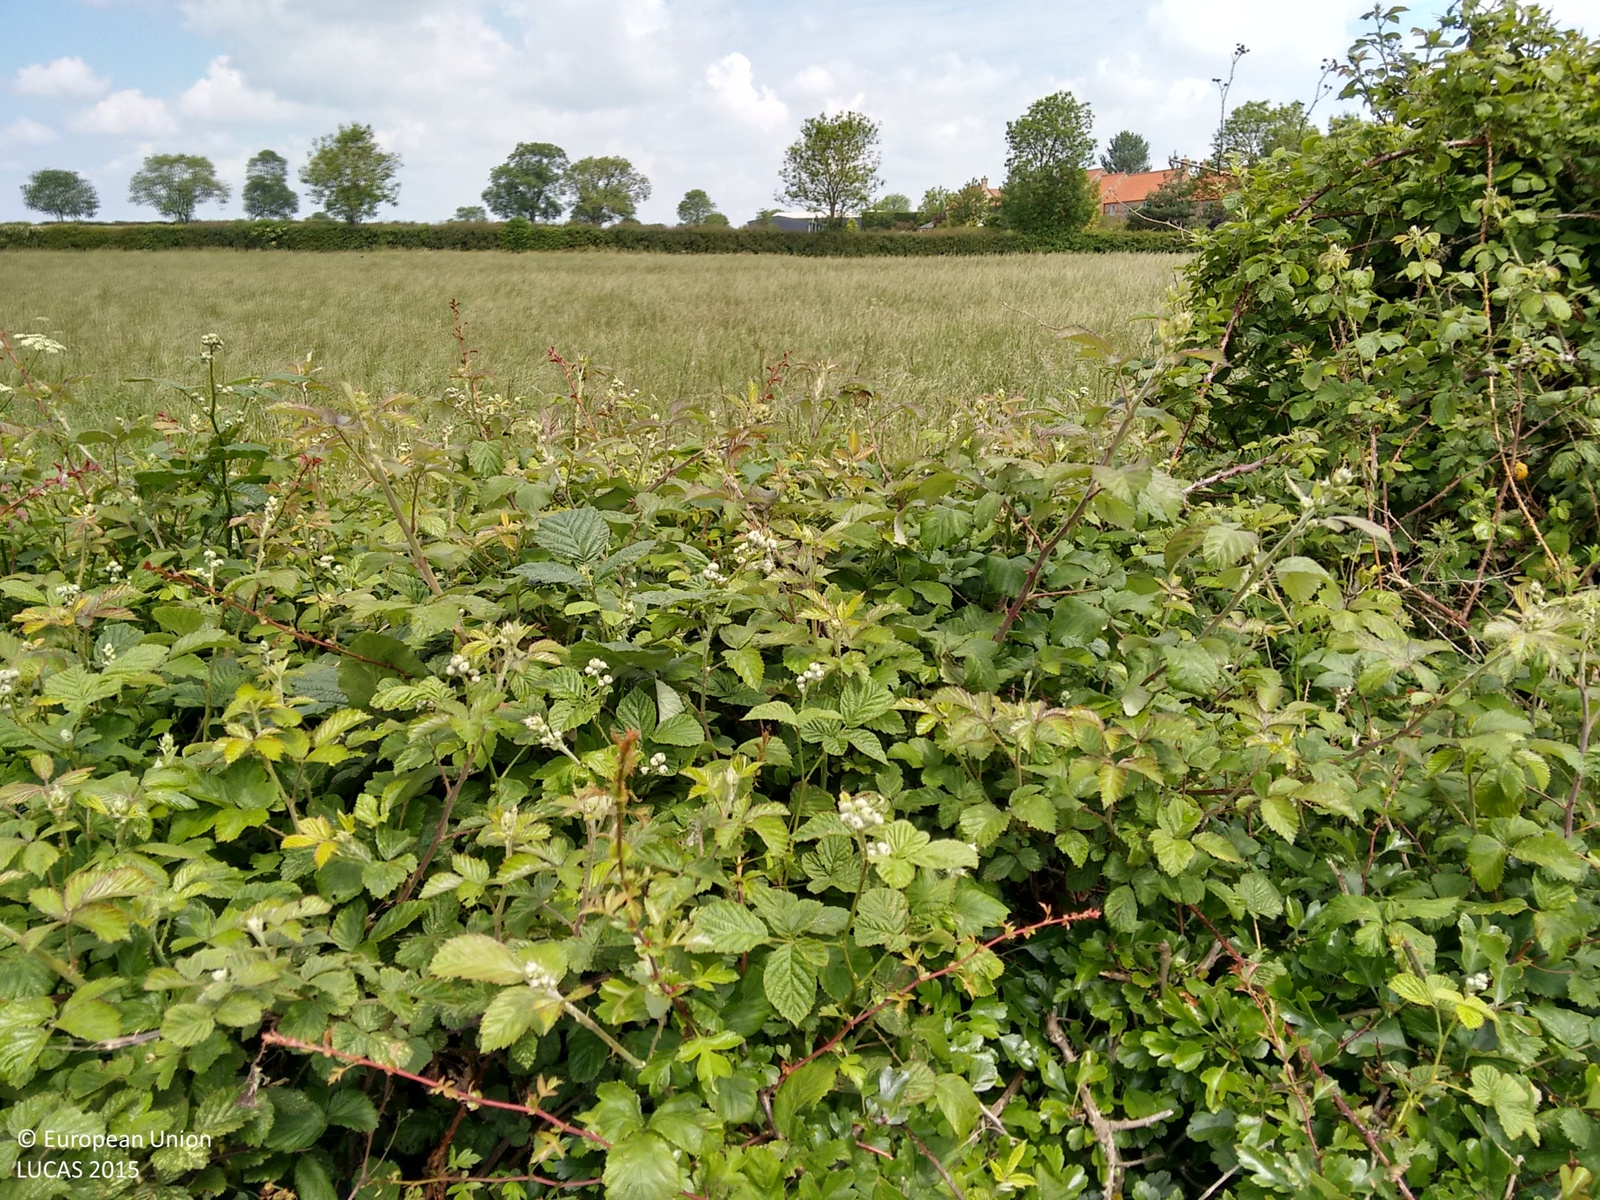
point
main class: Grassland
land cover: Grassland without tree/shrub cover
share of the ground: > 75 %
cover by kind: herbaceous plants 100 %
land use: Agriculture (excluding fallow land and kitchen gardens)
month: June
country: GB
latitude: 53.0252
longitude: -0.6097
